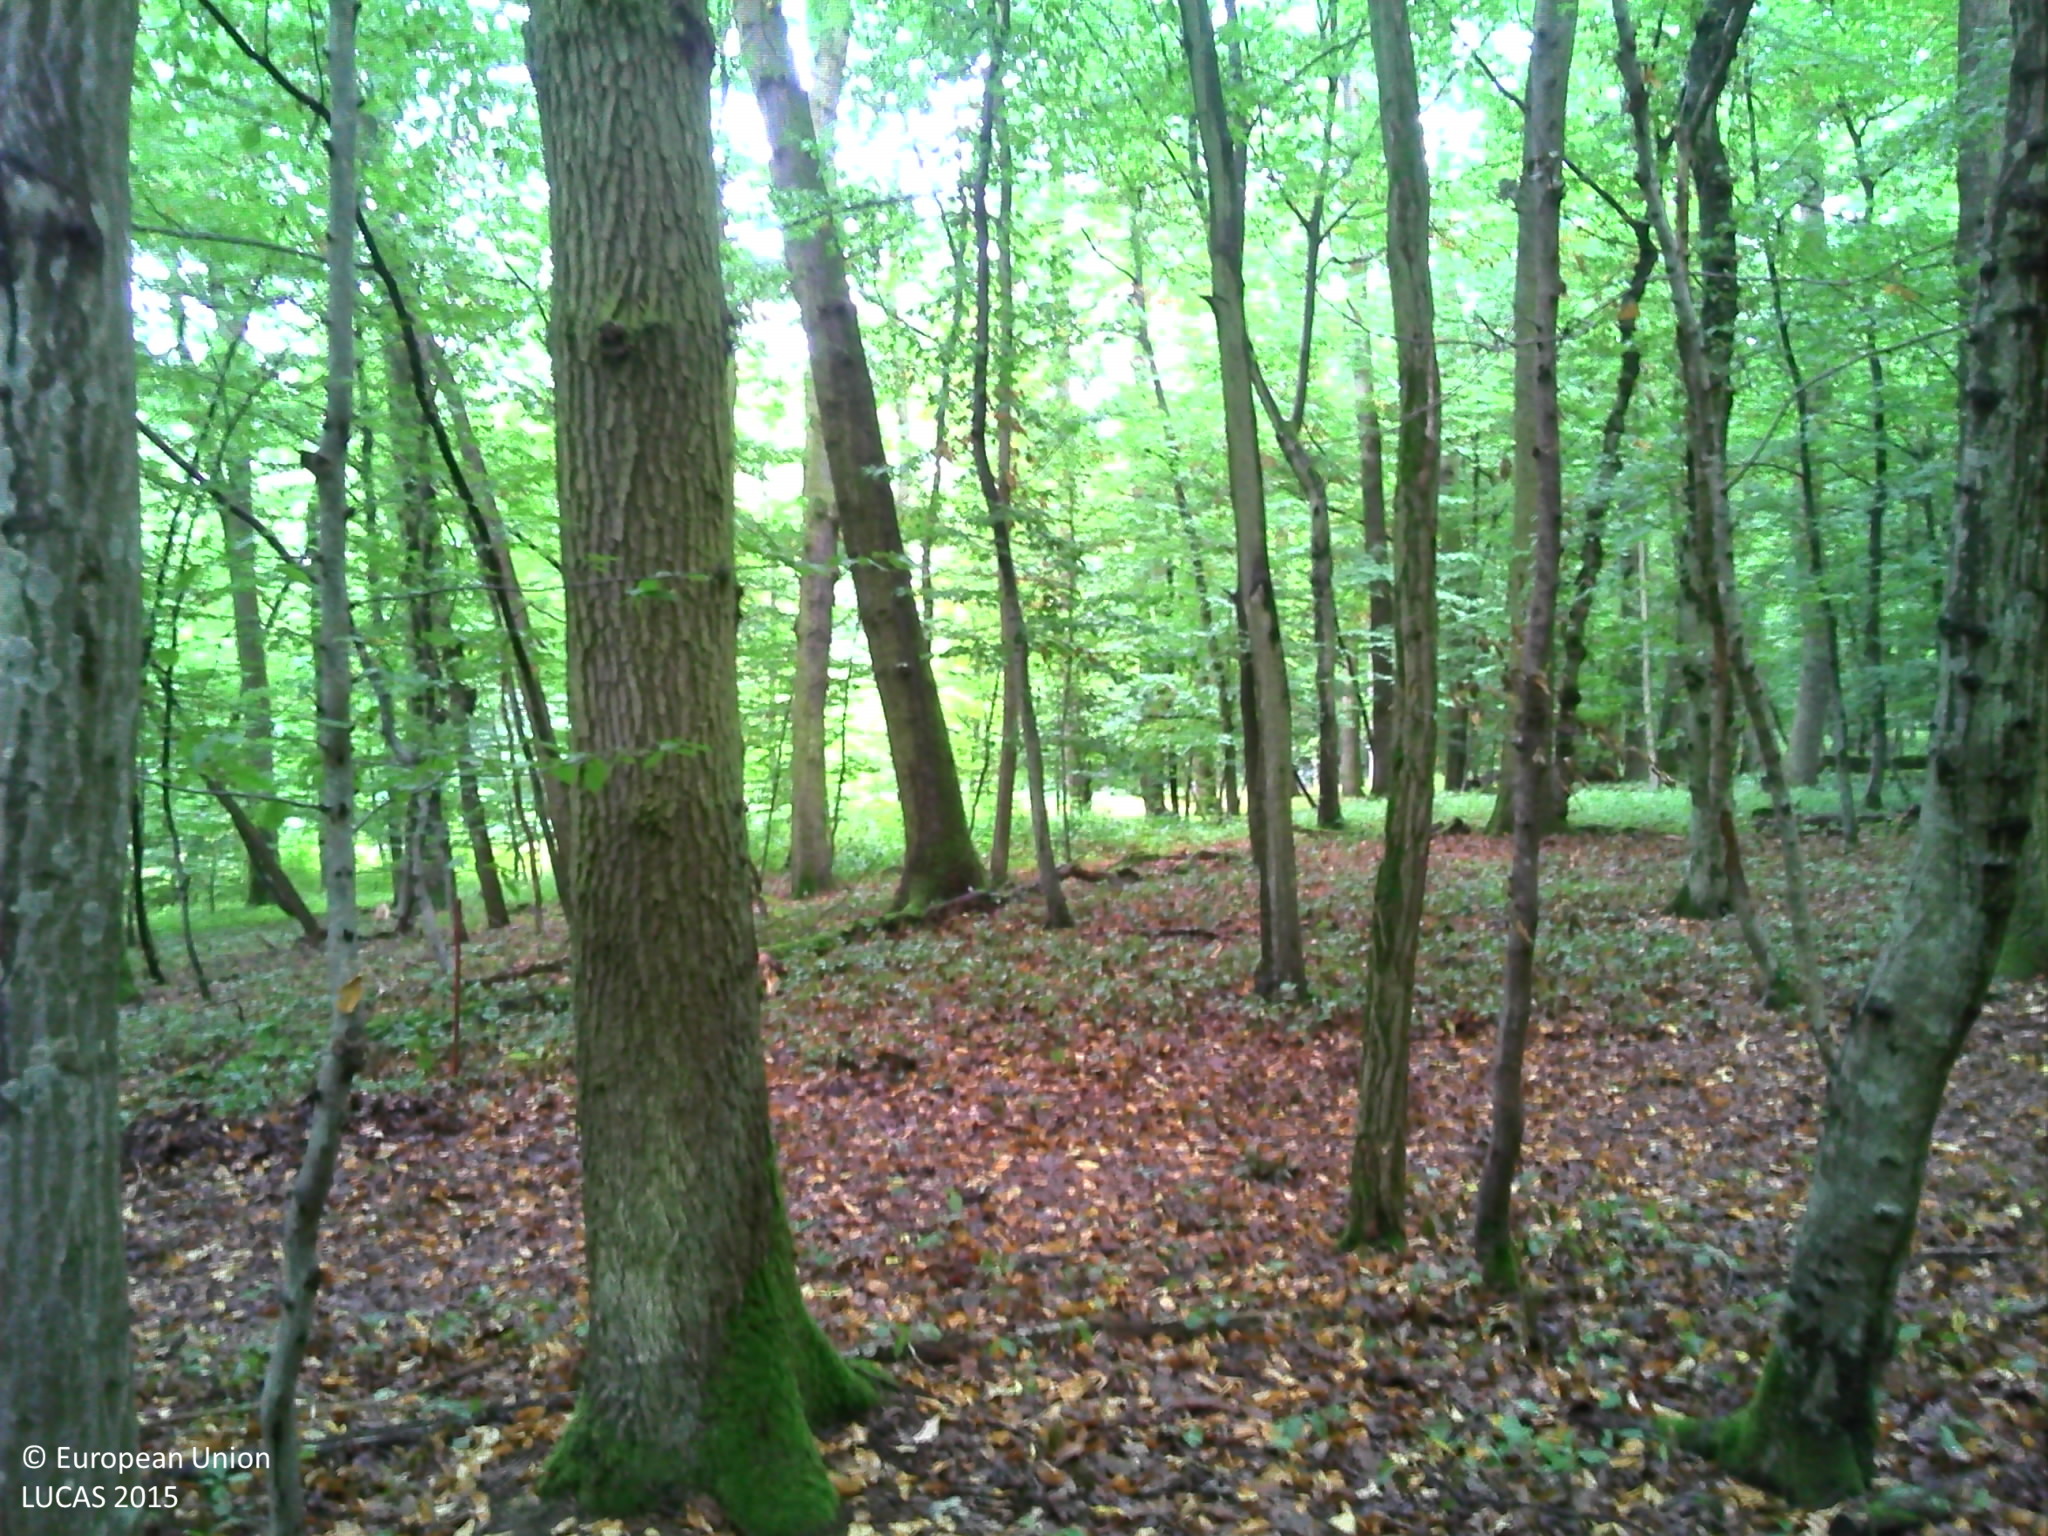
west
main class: Woodland
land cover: Broadleaved woodland
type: mesophytic deciduous forest
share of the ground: > 75 %
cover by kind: broadleaved forest trees 95 %, herbaceous plants 5 %
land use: Forestry
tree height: > 5 m
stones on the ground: < 10 %
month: August
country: FR
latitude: 48.7895
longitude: 7.5098
